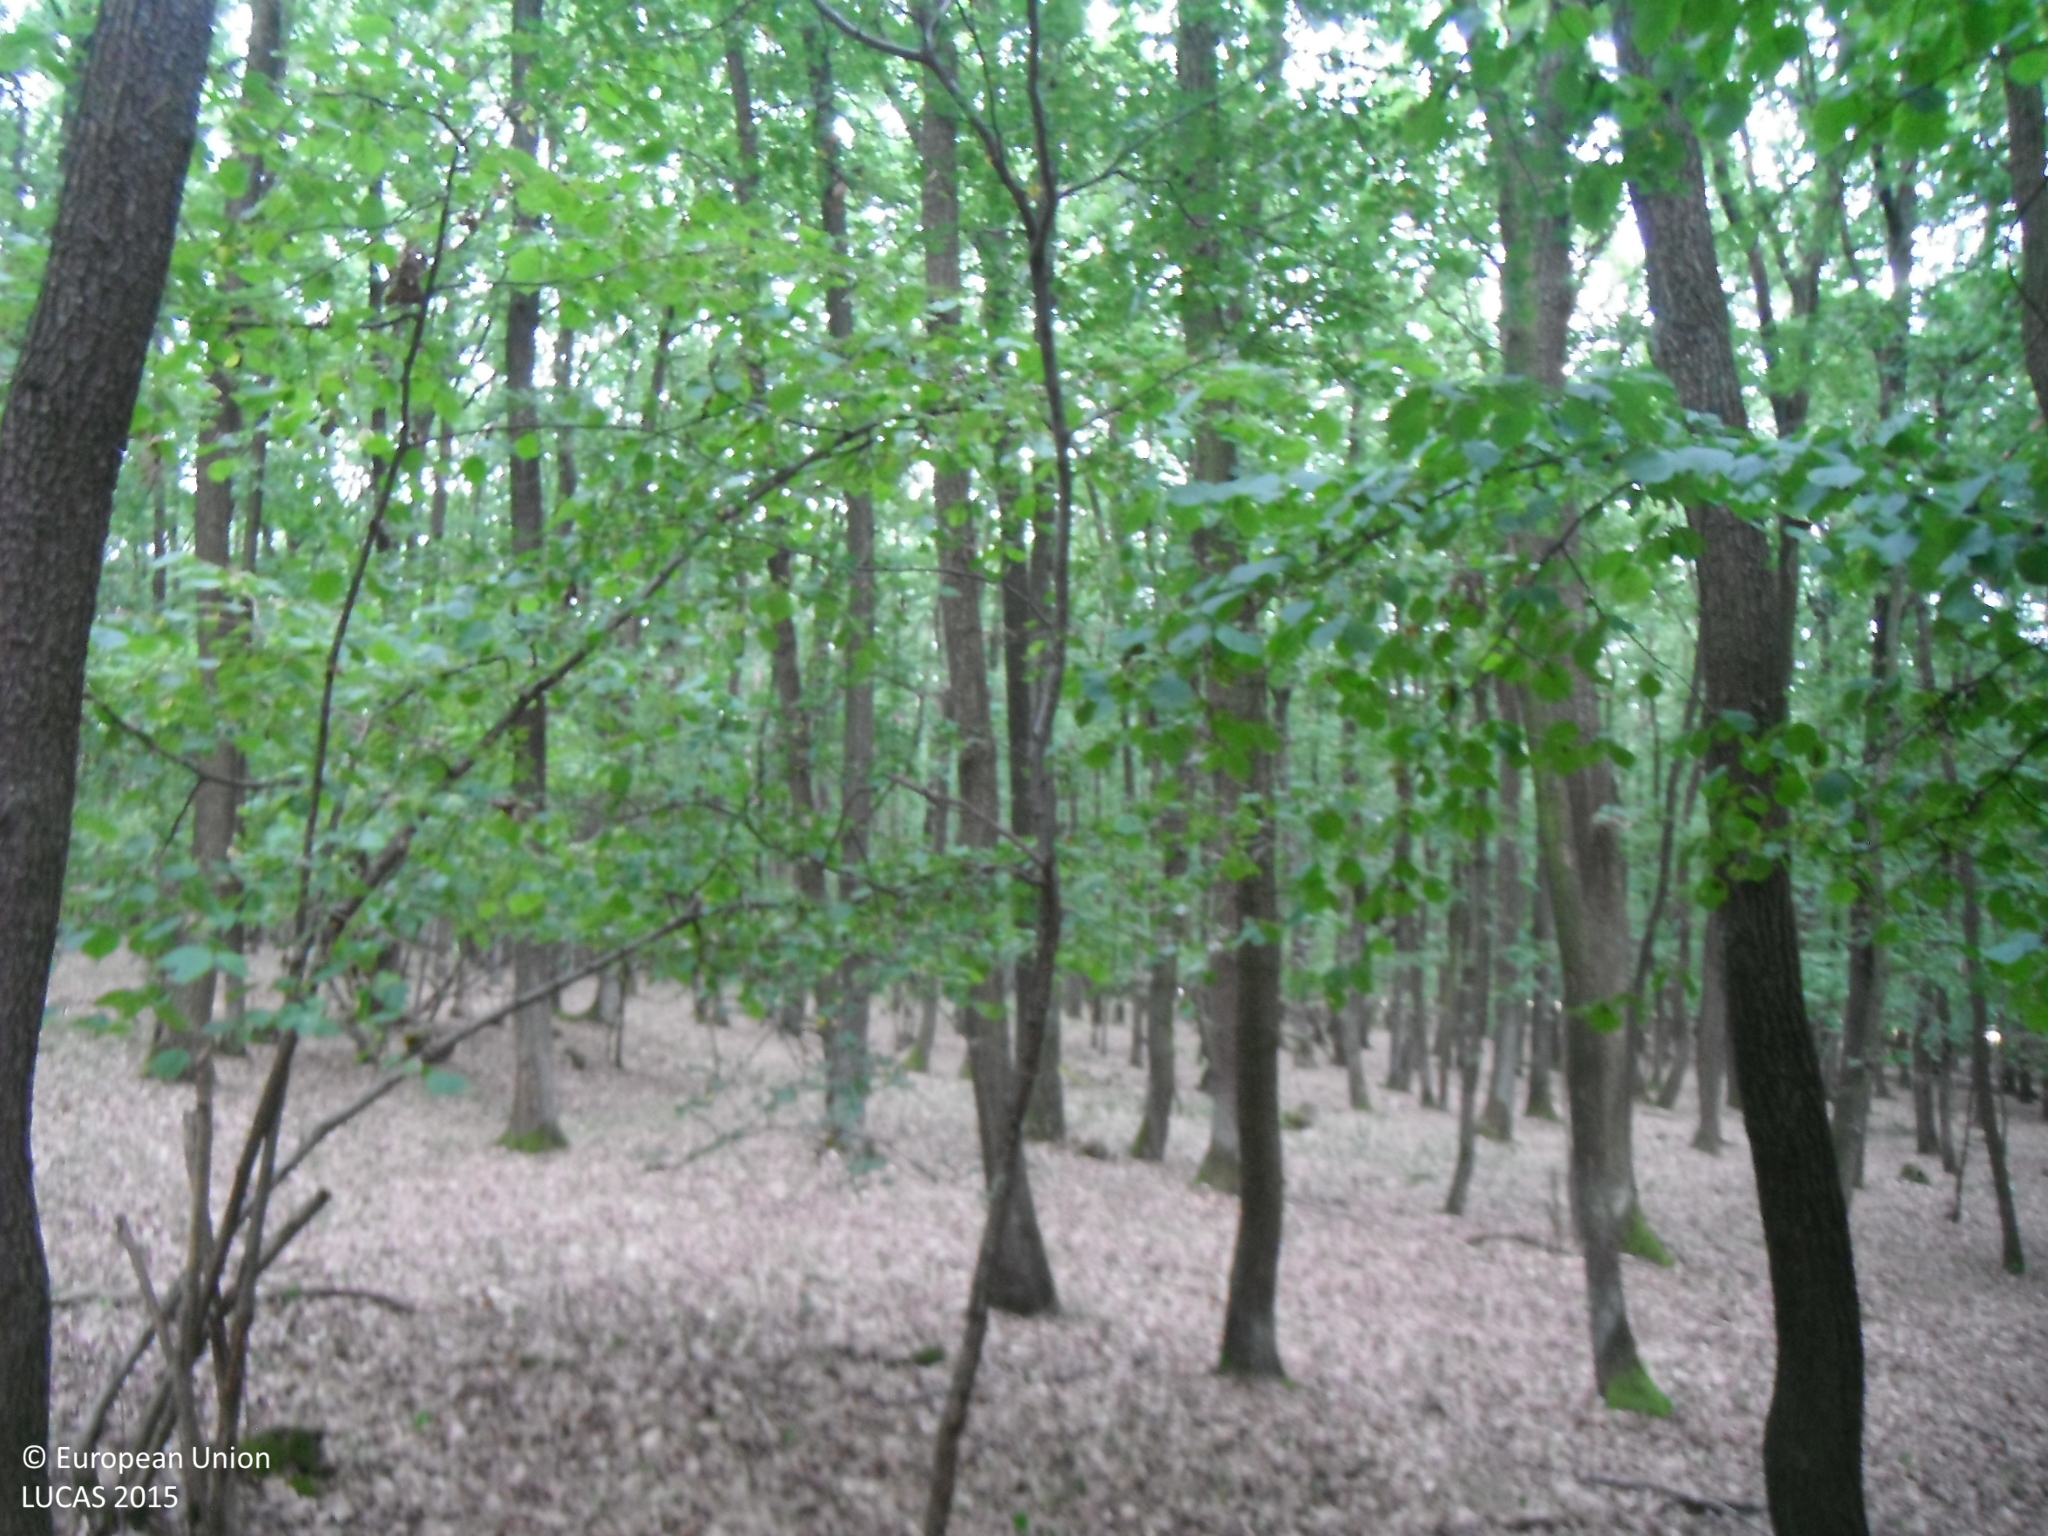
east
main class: Woodland
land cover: Broadleaved woodland
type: mesophytic deciduous forest
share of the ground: > 75 %
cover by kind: broadleaved forest trees 90 %, herbaceous plants 5 %, unconsolidated bare surface 5 %
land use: Forestry
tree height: > 5 m
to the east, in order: Broadleaved woodland; Tracks; Broadleaved woodland; Fences; Broadleaved woodland
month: July
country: SK
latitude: 48.7965
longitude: 17.2659
